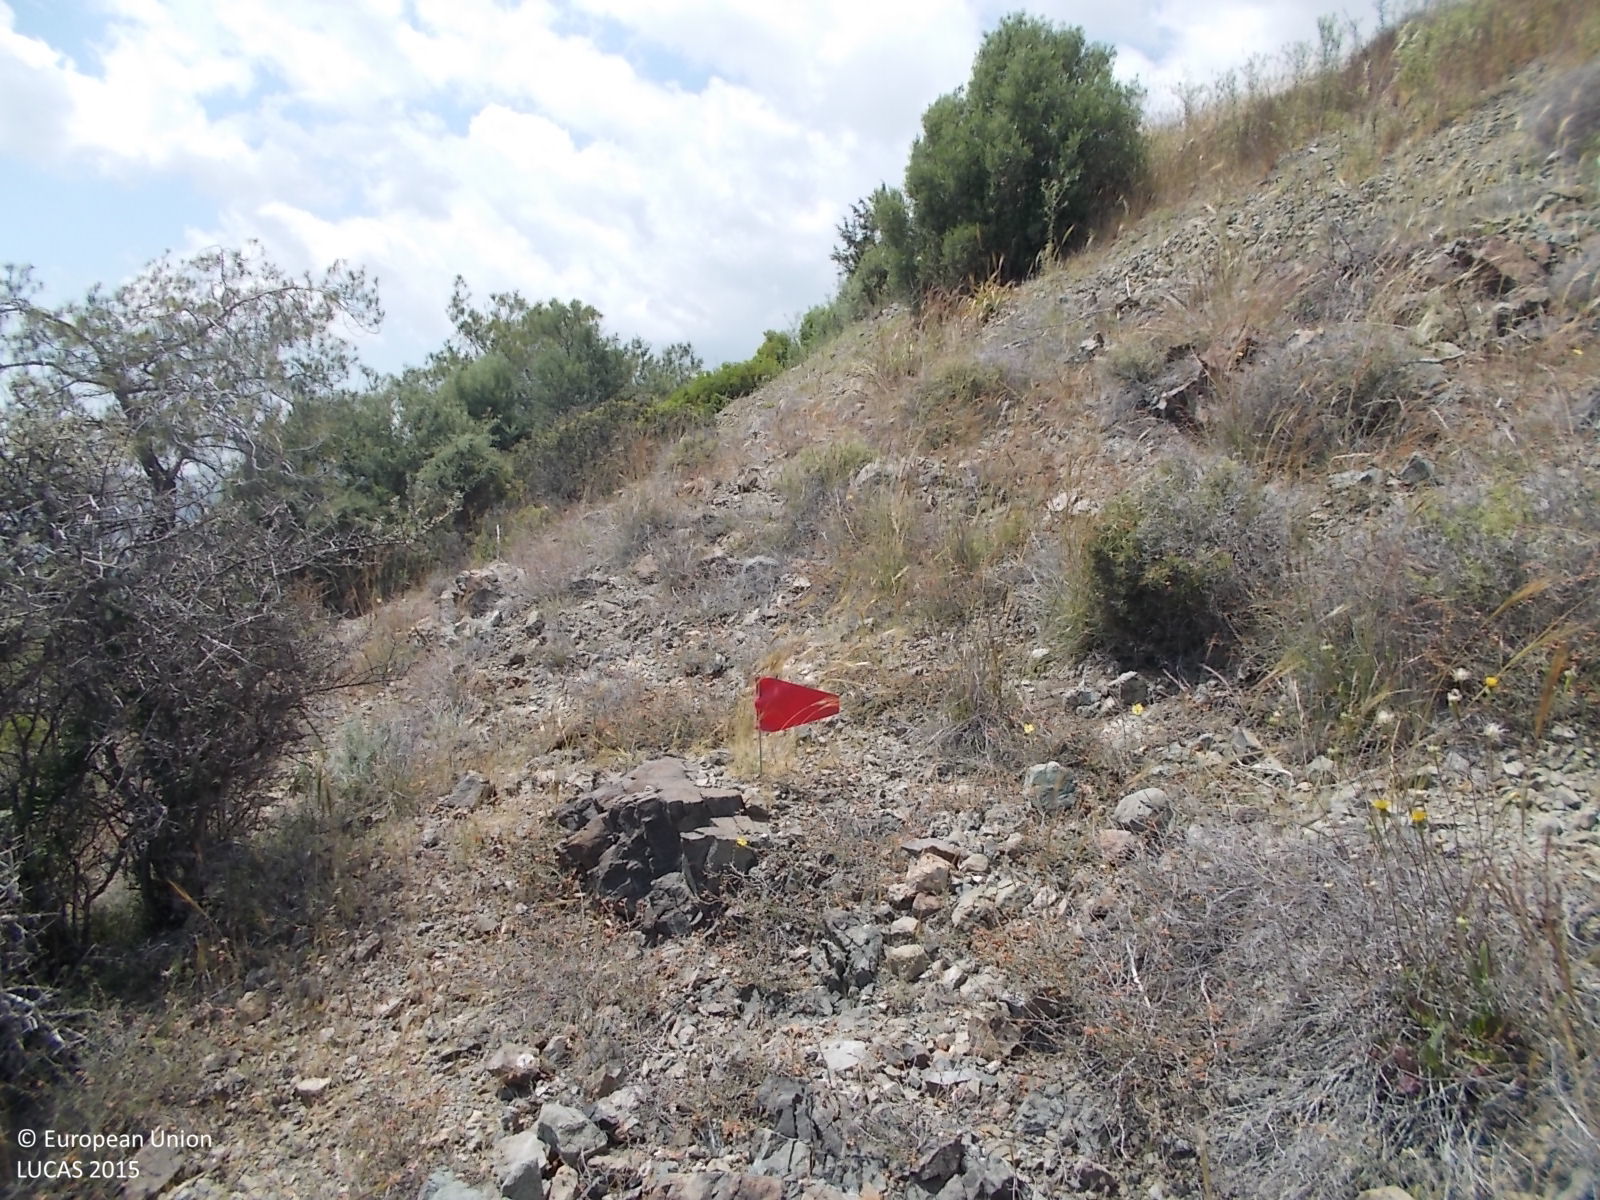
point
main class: Shrubland
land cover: Shrubland with sparse tree cover
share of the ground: 50 - 75 %
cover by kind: shrubs 60 %, unconsolidated bare surface 35 %, broadleaved forest trees 5 %
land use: Semi-natural and natural areas not in use
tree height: > 5 m
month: April
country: CY
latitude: 34.7620
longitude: 33.1246
